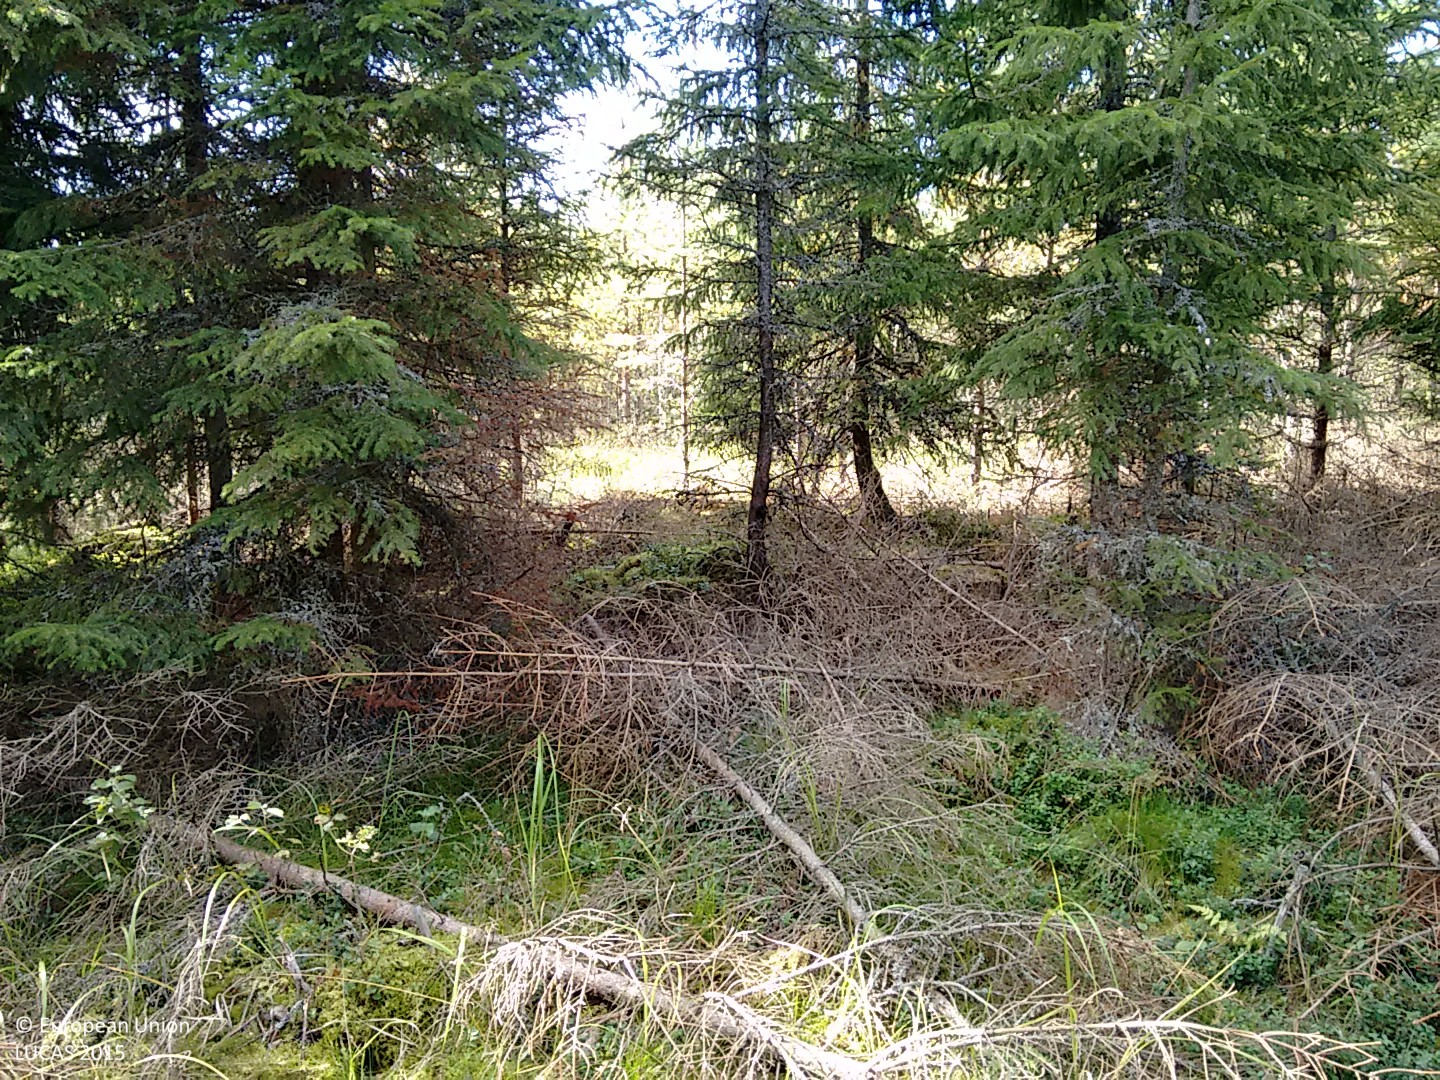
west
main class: Woodland
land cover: Spruce dominated coniferous woodland
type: hemiboreal forest and nemoral coniferous forest and mixed broadleaved-coniferous forest
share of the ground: > 75 %
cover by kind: coniferous forest trees 90 %, shrubs 5 %, lichens and mosses 5 %
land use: Forestry
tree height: > 5 m
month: September
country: FI
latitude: 60.9997
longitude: 21.7615
